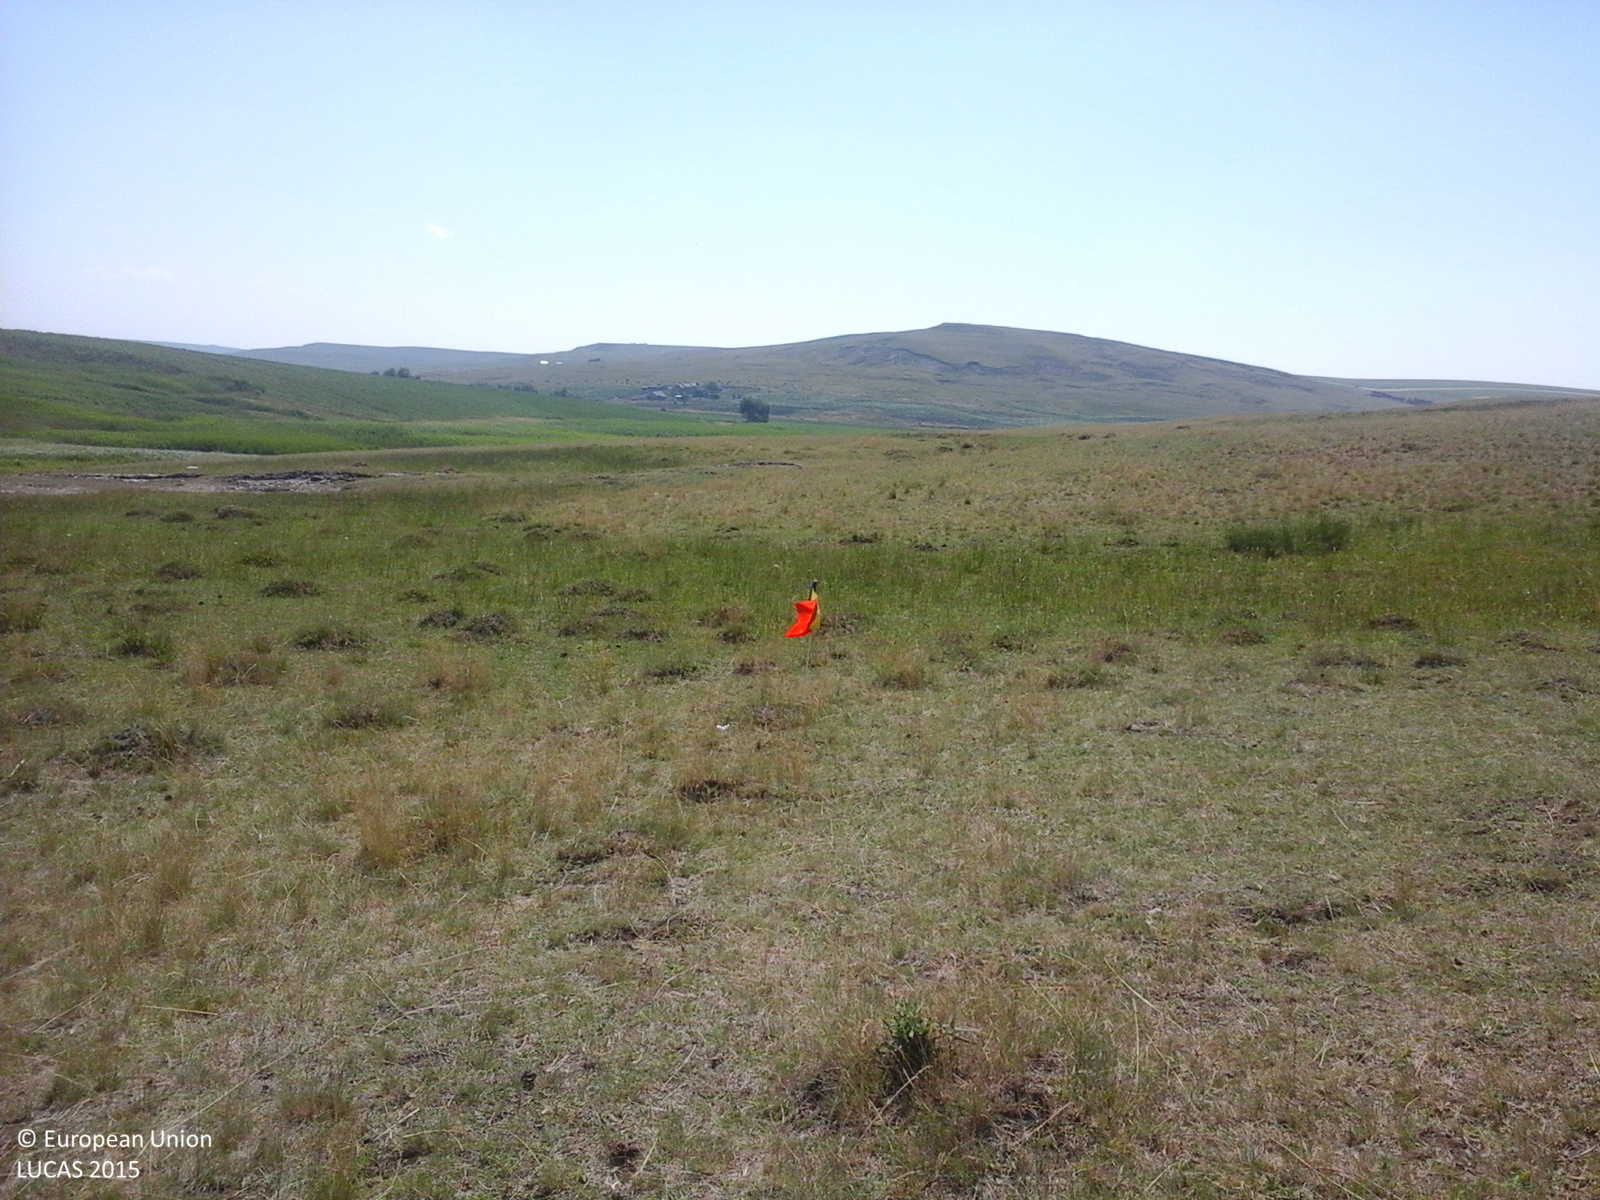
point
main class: Grassland
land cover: Grassland without tree/shrub cover
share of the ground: > 75 %
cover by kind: herbaceous plants 100 %
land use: Agriculture (excluding fallow land and kitchen gardens)
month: June
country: RO
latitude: 47.7153
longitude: 27.1304
